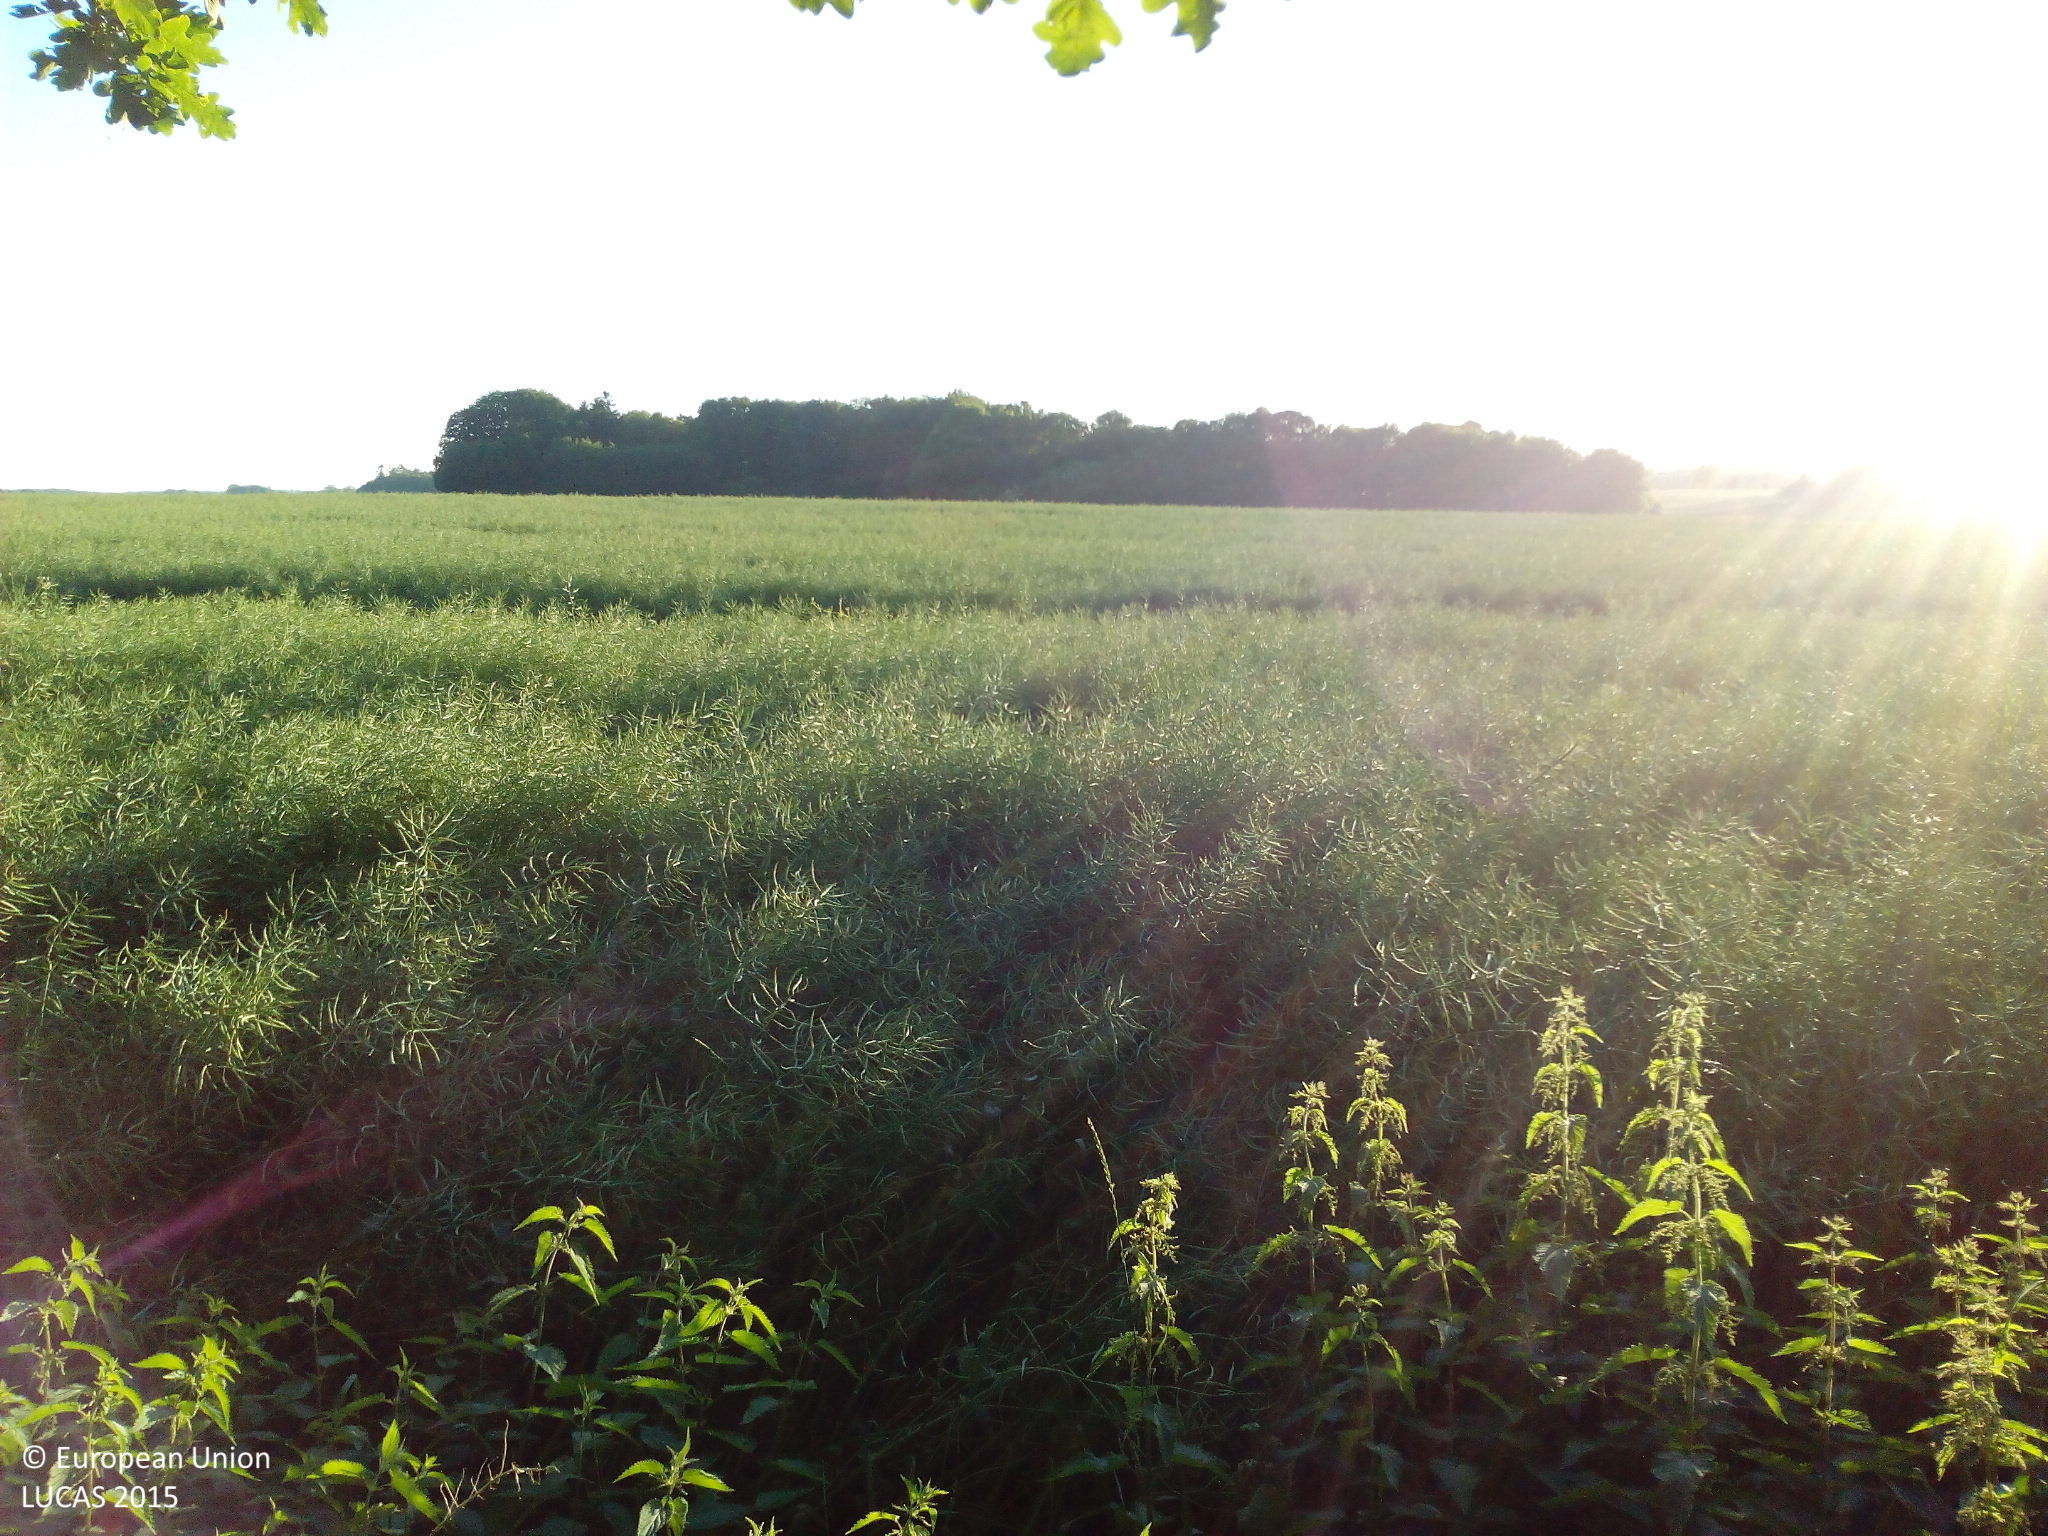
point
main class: Cropland
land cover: Rape and turnip rape
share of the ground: > 75 %
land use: Agriculture (excluding fallow land and kitchen gardens)
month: June
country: DK
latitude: 56.3651
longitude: 10.7922
